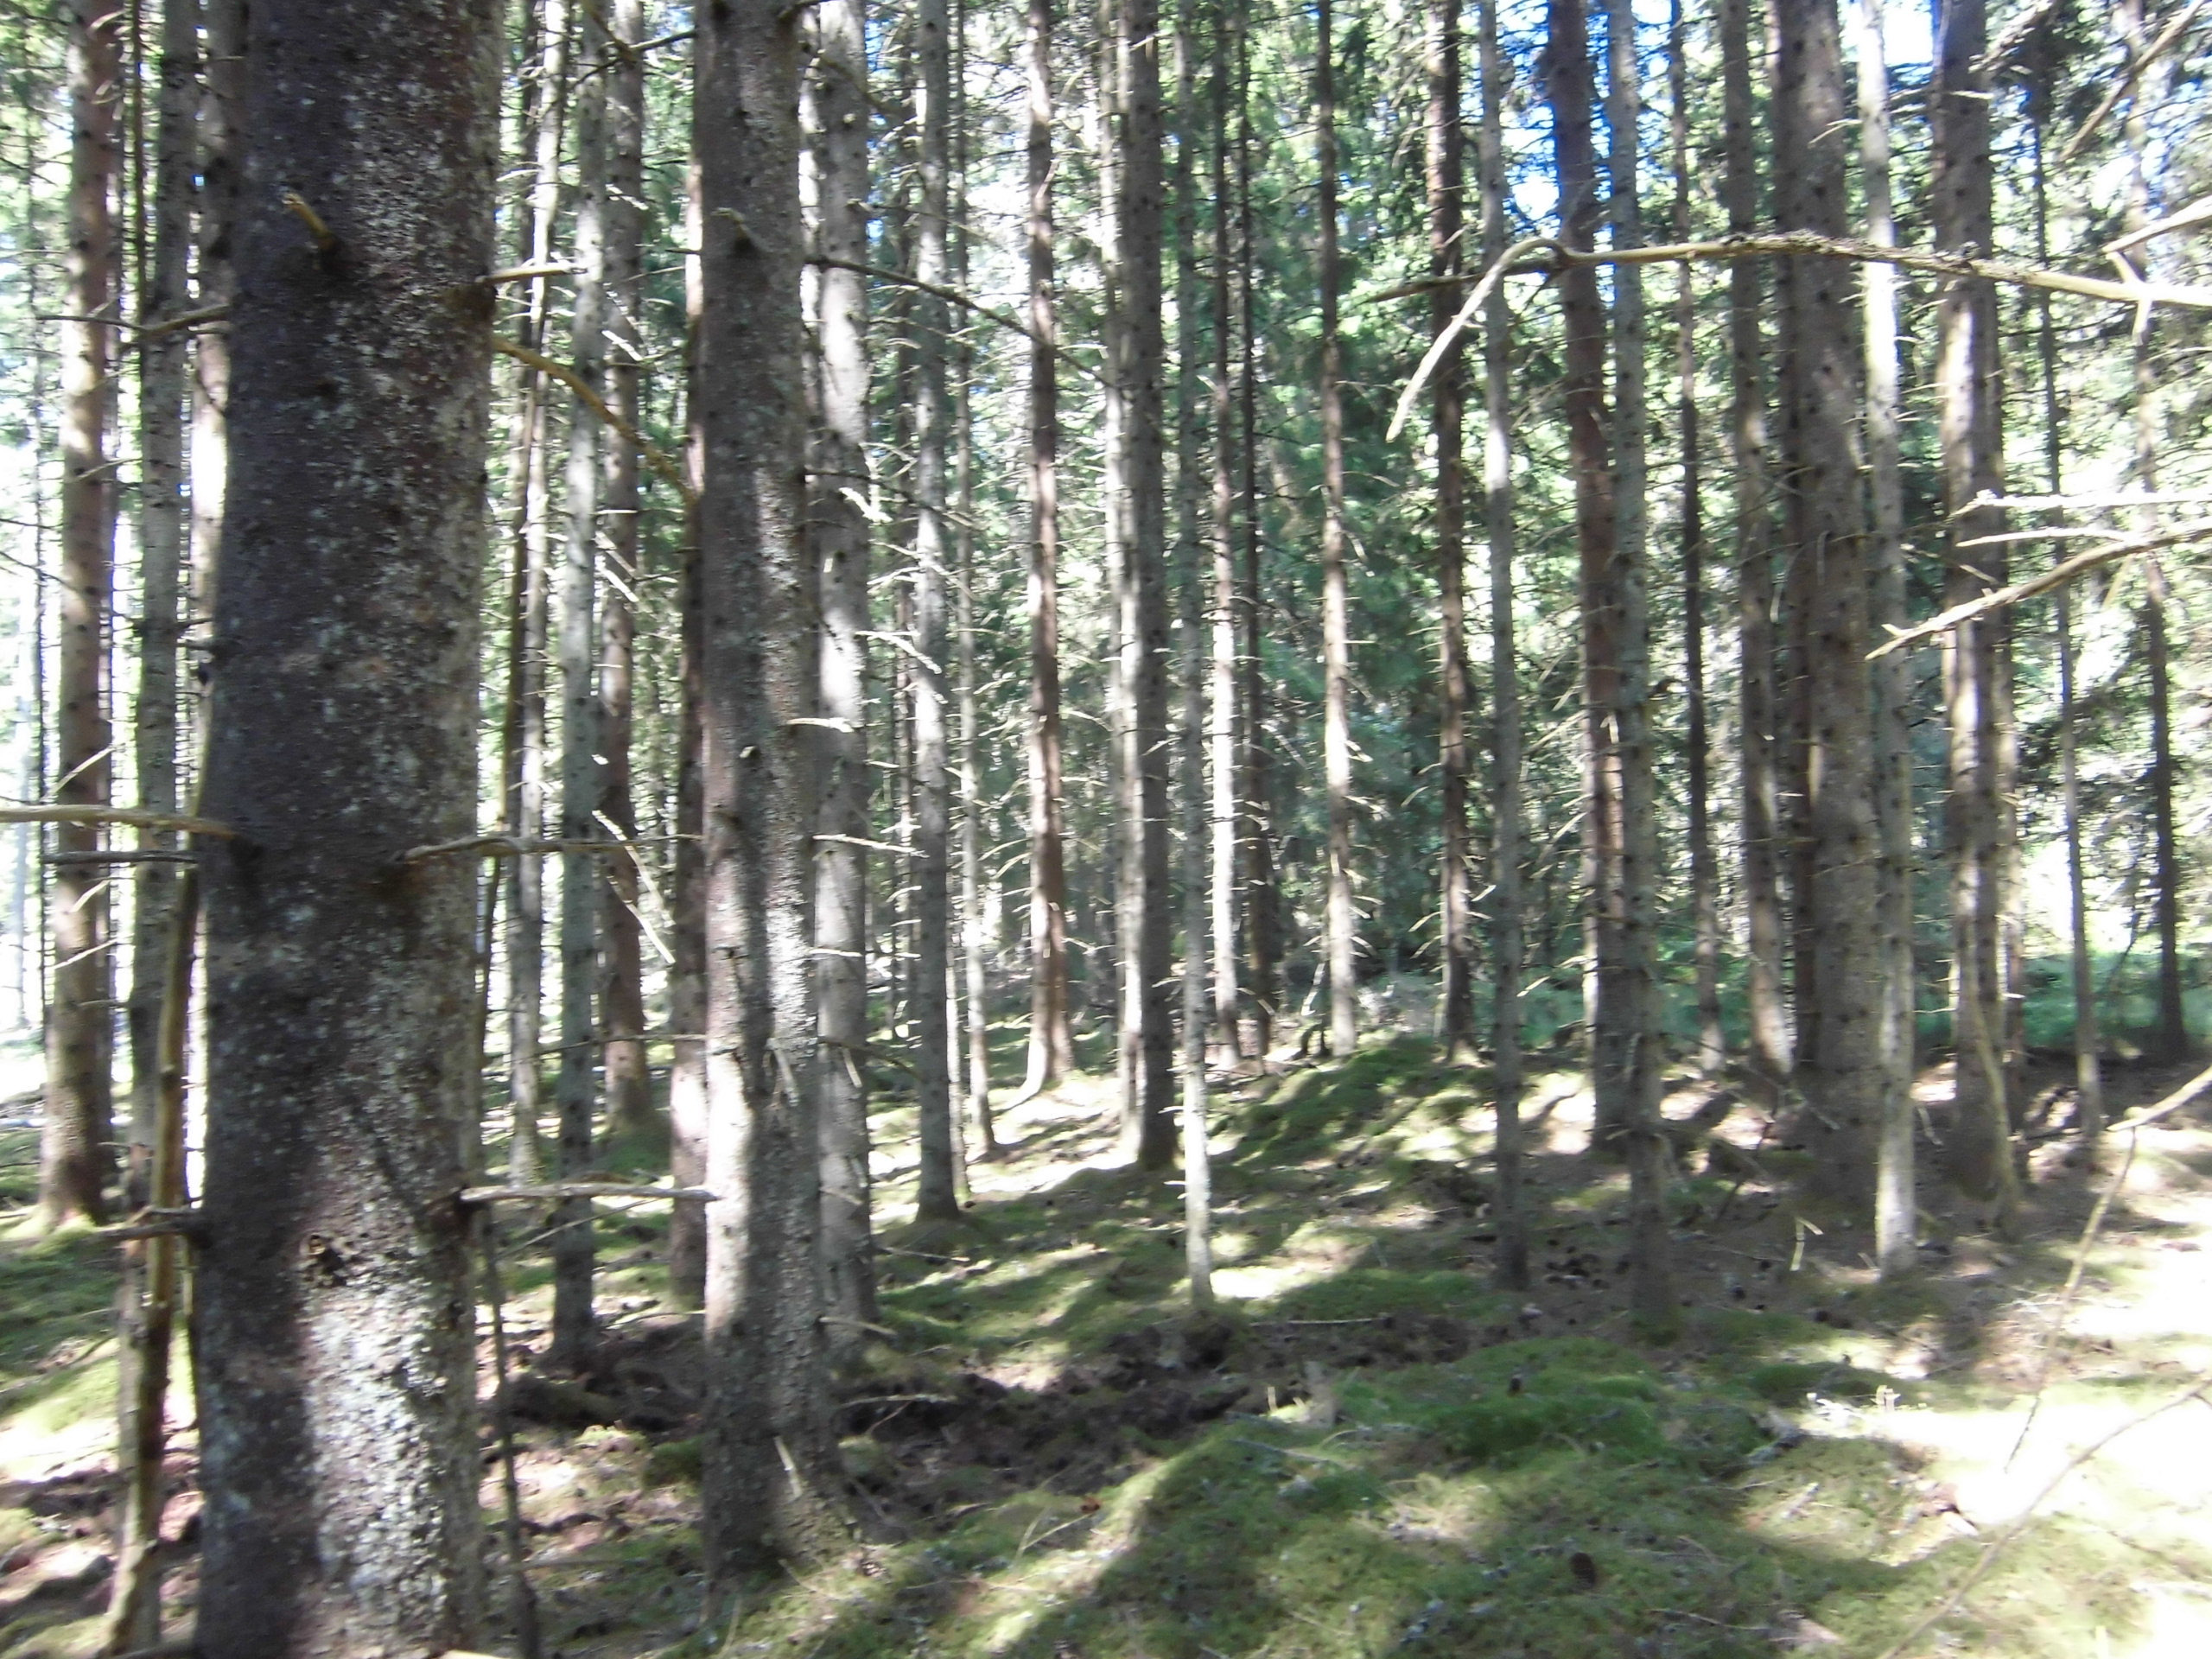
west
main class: Woodland
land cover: Spruce dominated coniferous woodland
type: boreal forest
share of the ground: 50 - 75 %
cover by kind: coniferous forest trees 65 %, lichens and mosses 20 %, unconsolidated bare surface 15 %
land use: Forestry
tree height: > 5 m
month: July
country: SE
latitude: 57.2717
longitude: 14.7227
